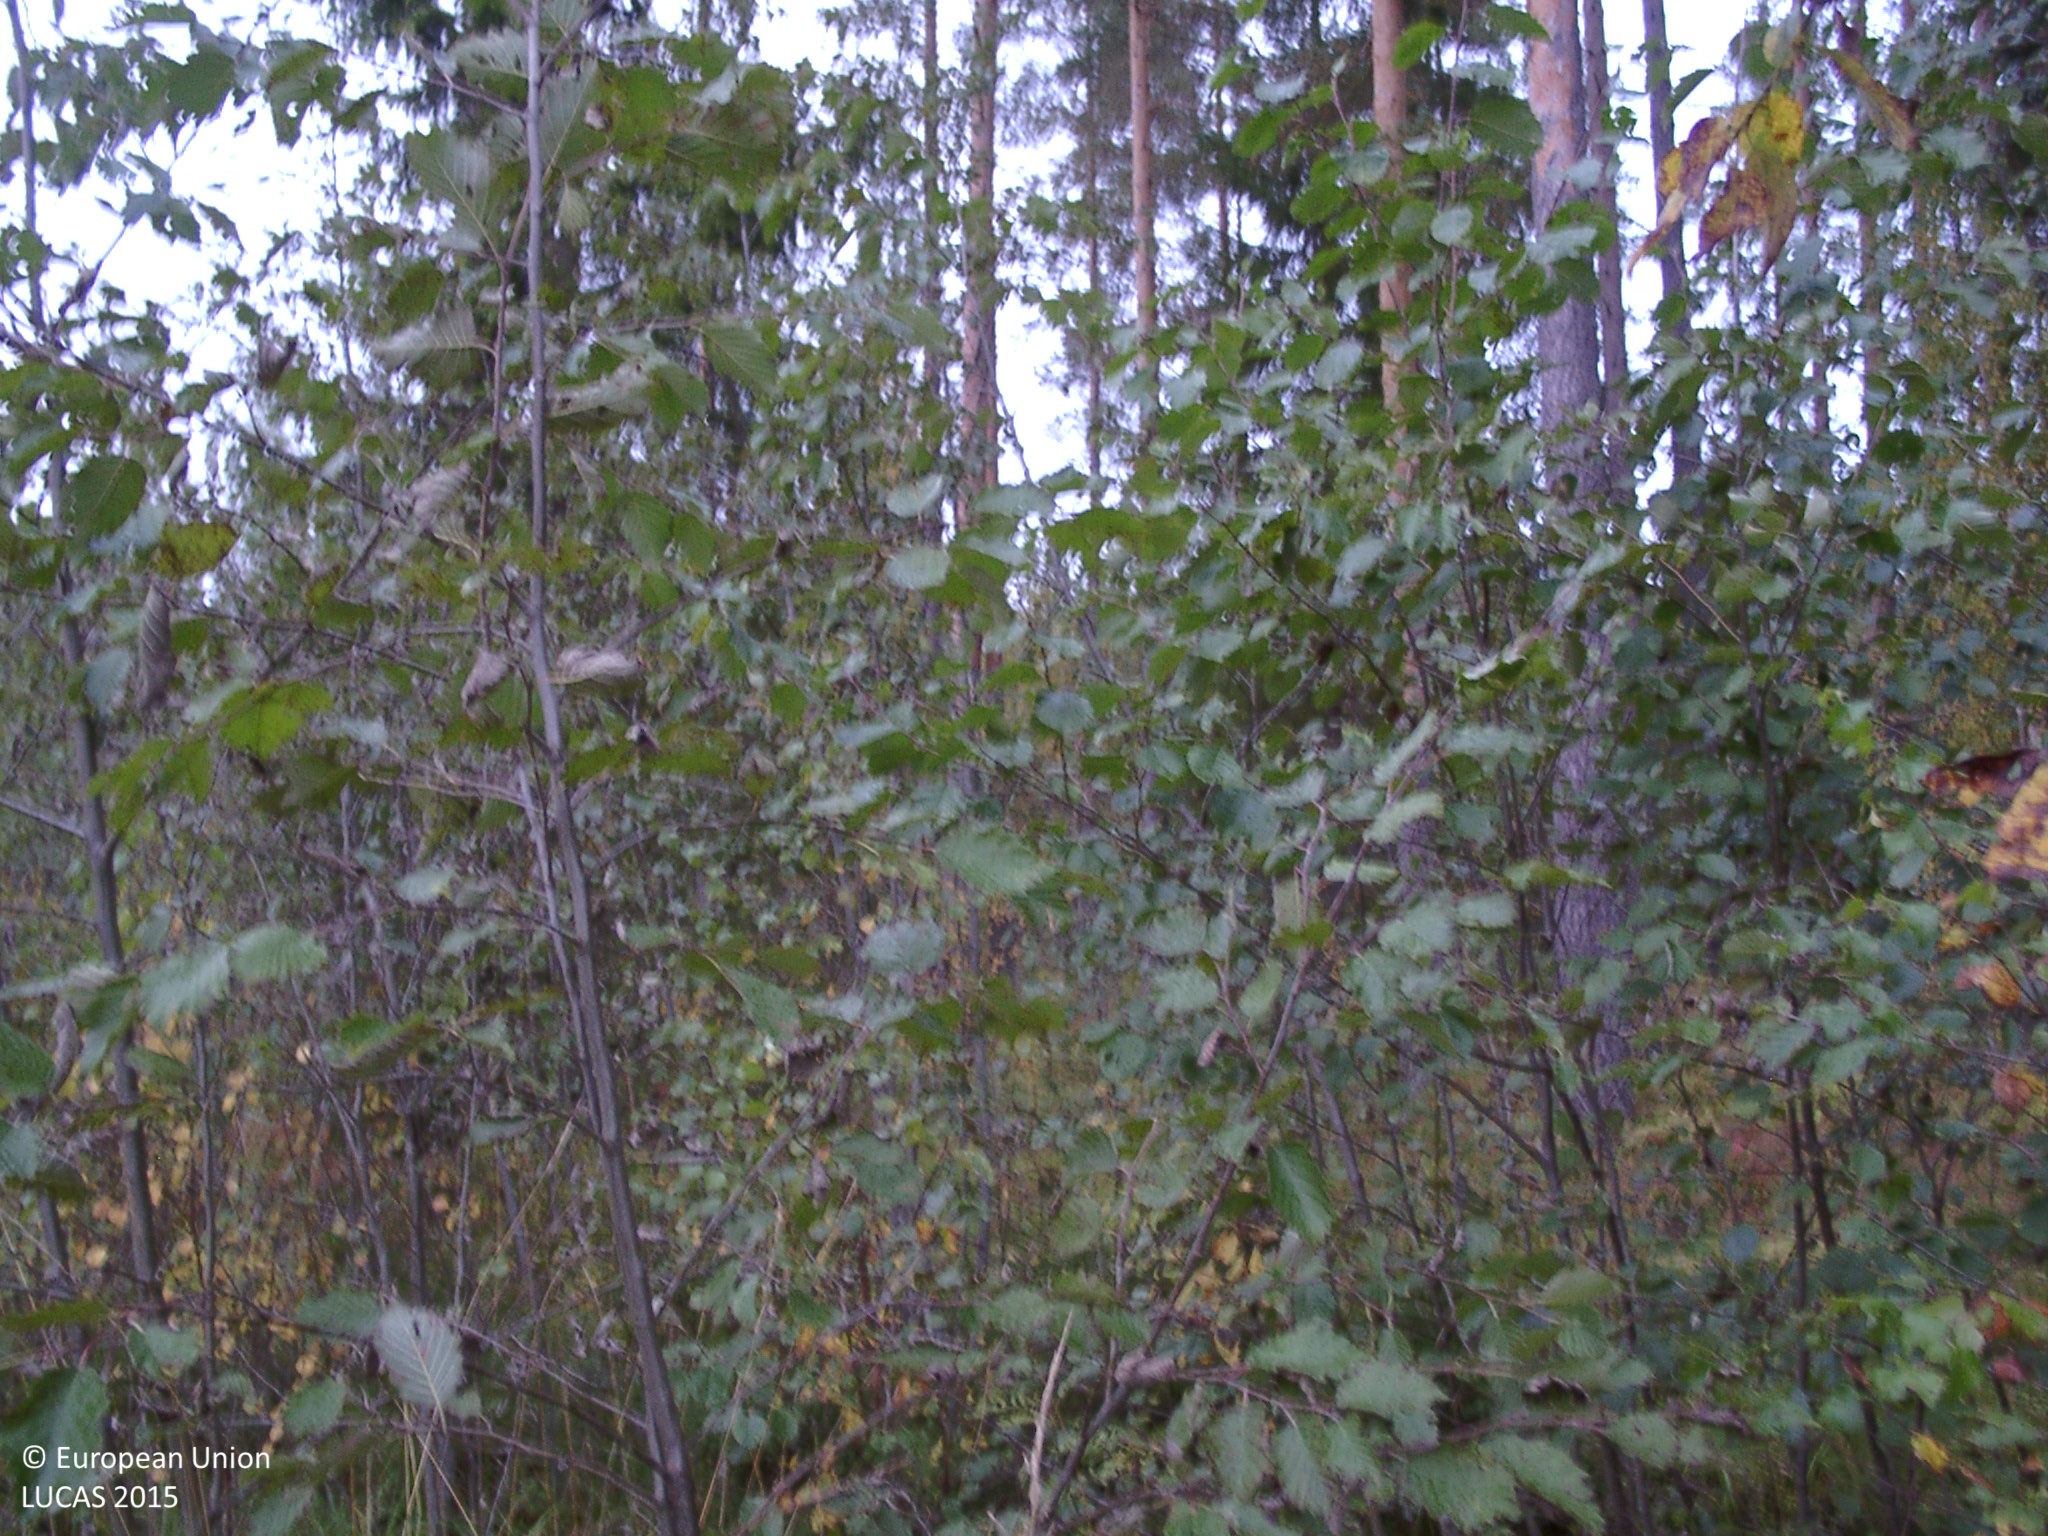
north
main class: Woodland
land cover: Broadleaved woodland
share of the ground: 25 - 50 %
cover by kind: herbaceous plants 40 %, broadleaved forest trees 30 %, shrubs 15 %, lichens and mosses 10 %, coniferous forest trees 5 %
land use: Forestry
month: September
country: FI
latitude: 62.8069
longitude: 25.9484
